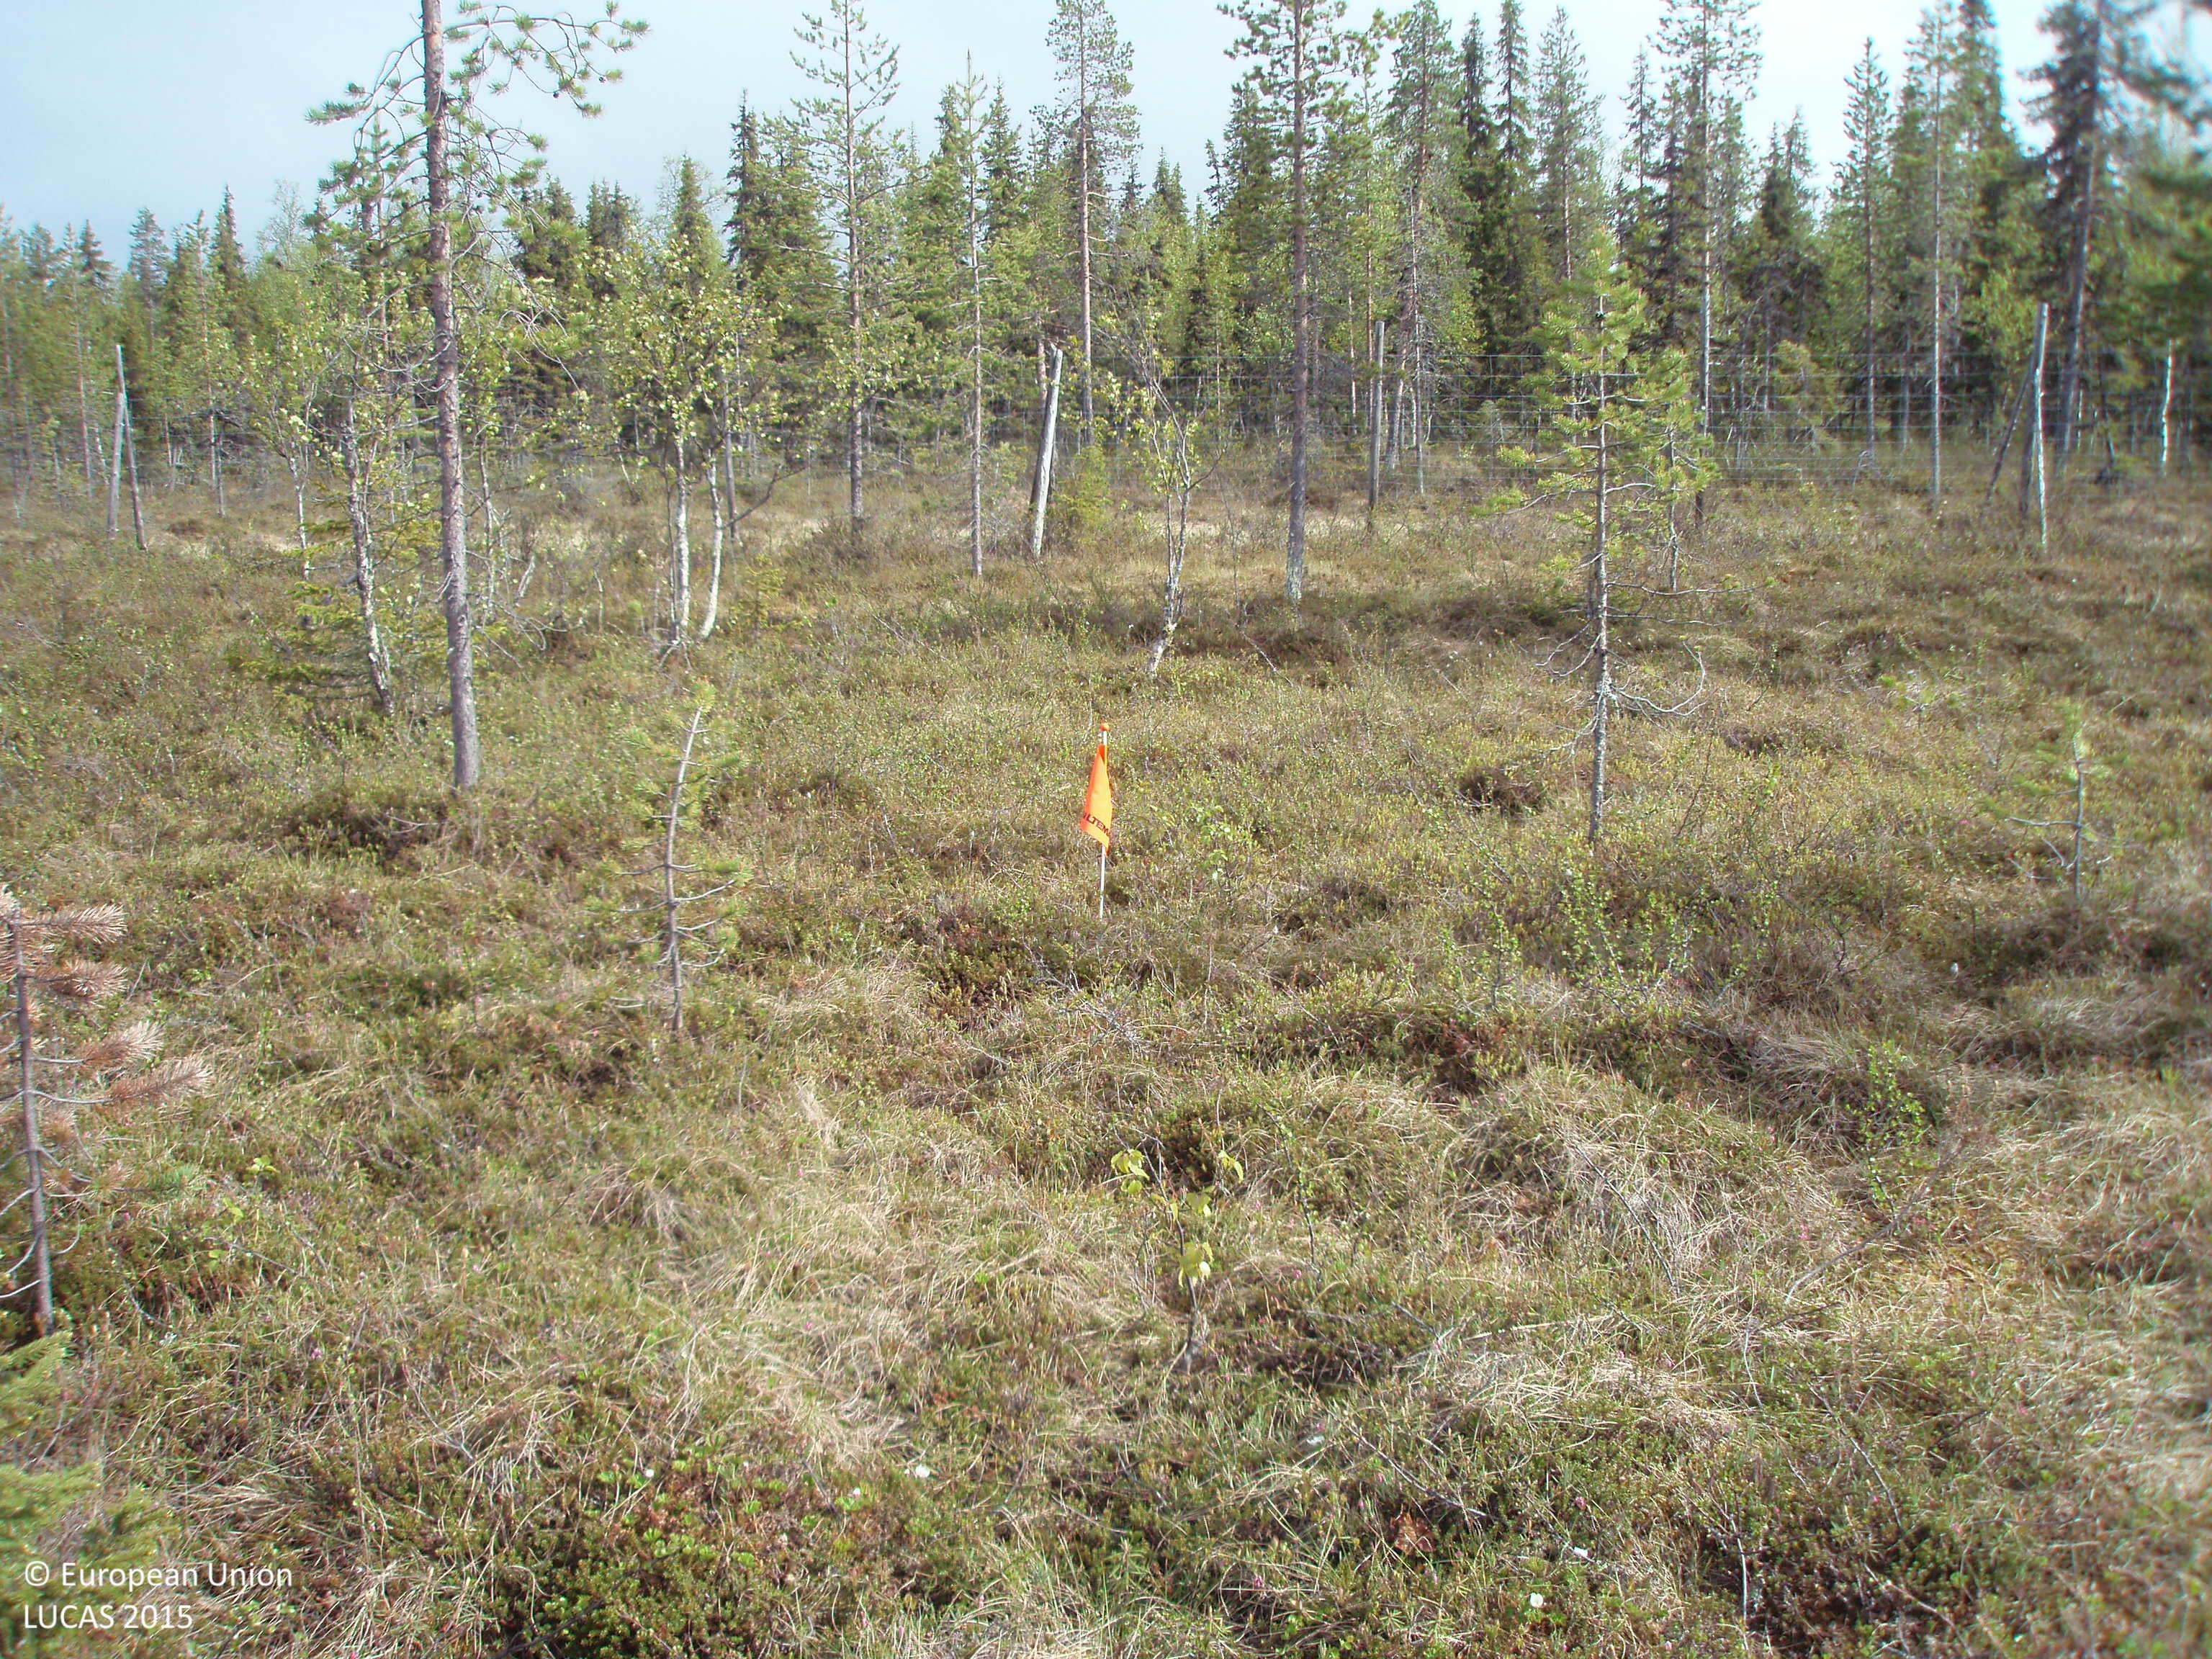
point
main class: Woodland
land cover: Pine dominated coniferous woodland
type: mire and swamp forests
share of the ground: 10 - 25 %
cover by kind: shrubs 50 %, lichens and mosses 20 %, coniferous forest trees 15 %, herbaceous plants 10 %, broadleaved forest trees 5 %
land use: Semi-natural and natural areas not in use
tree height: > 5 m
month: June
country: FI
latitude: 67.9756
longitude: 26.8222
